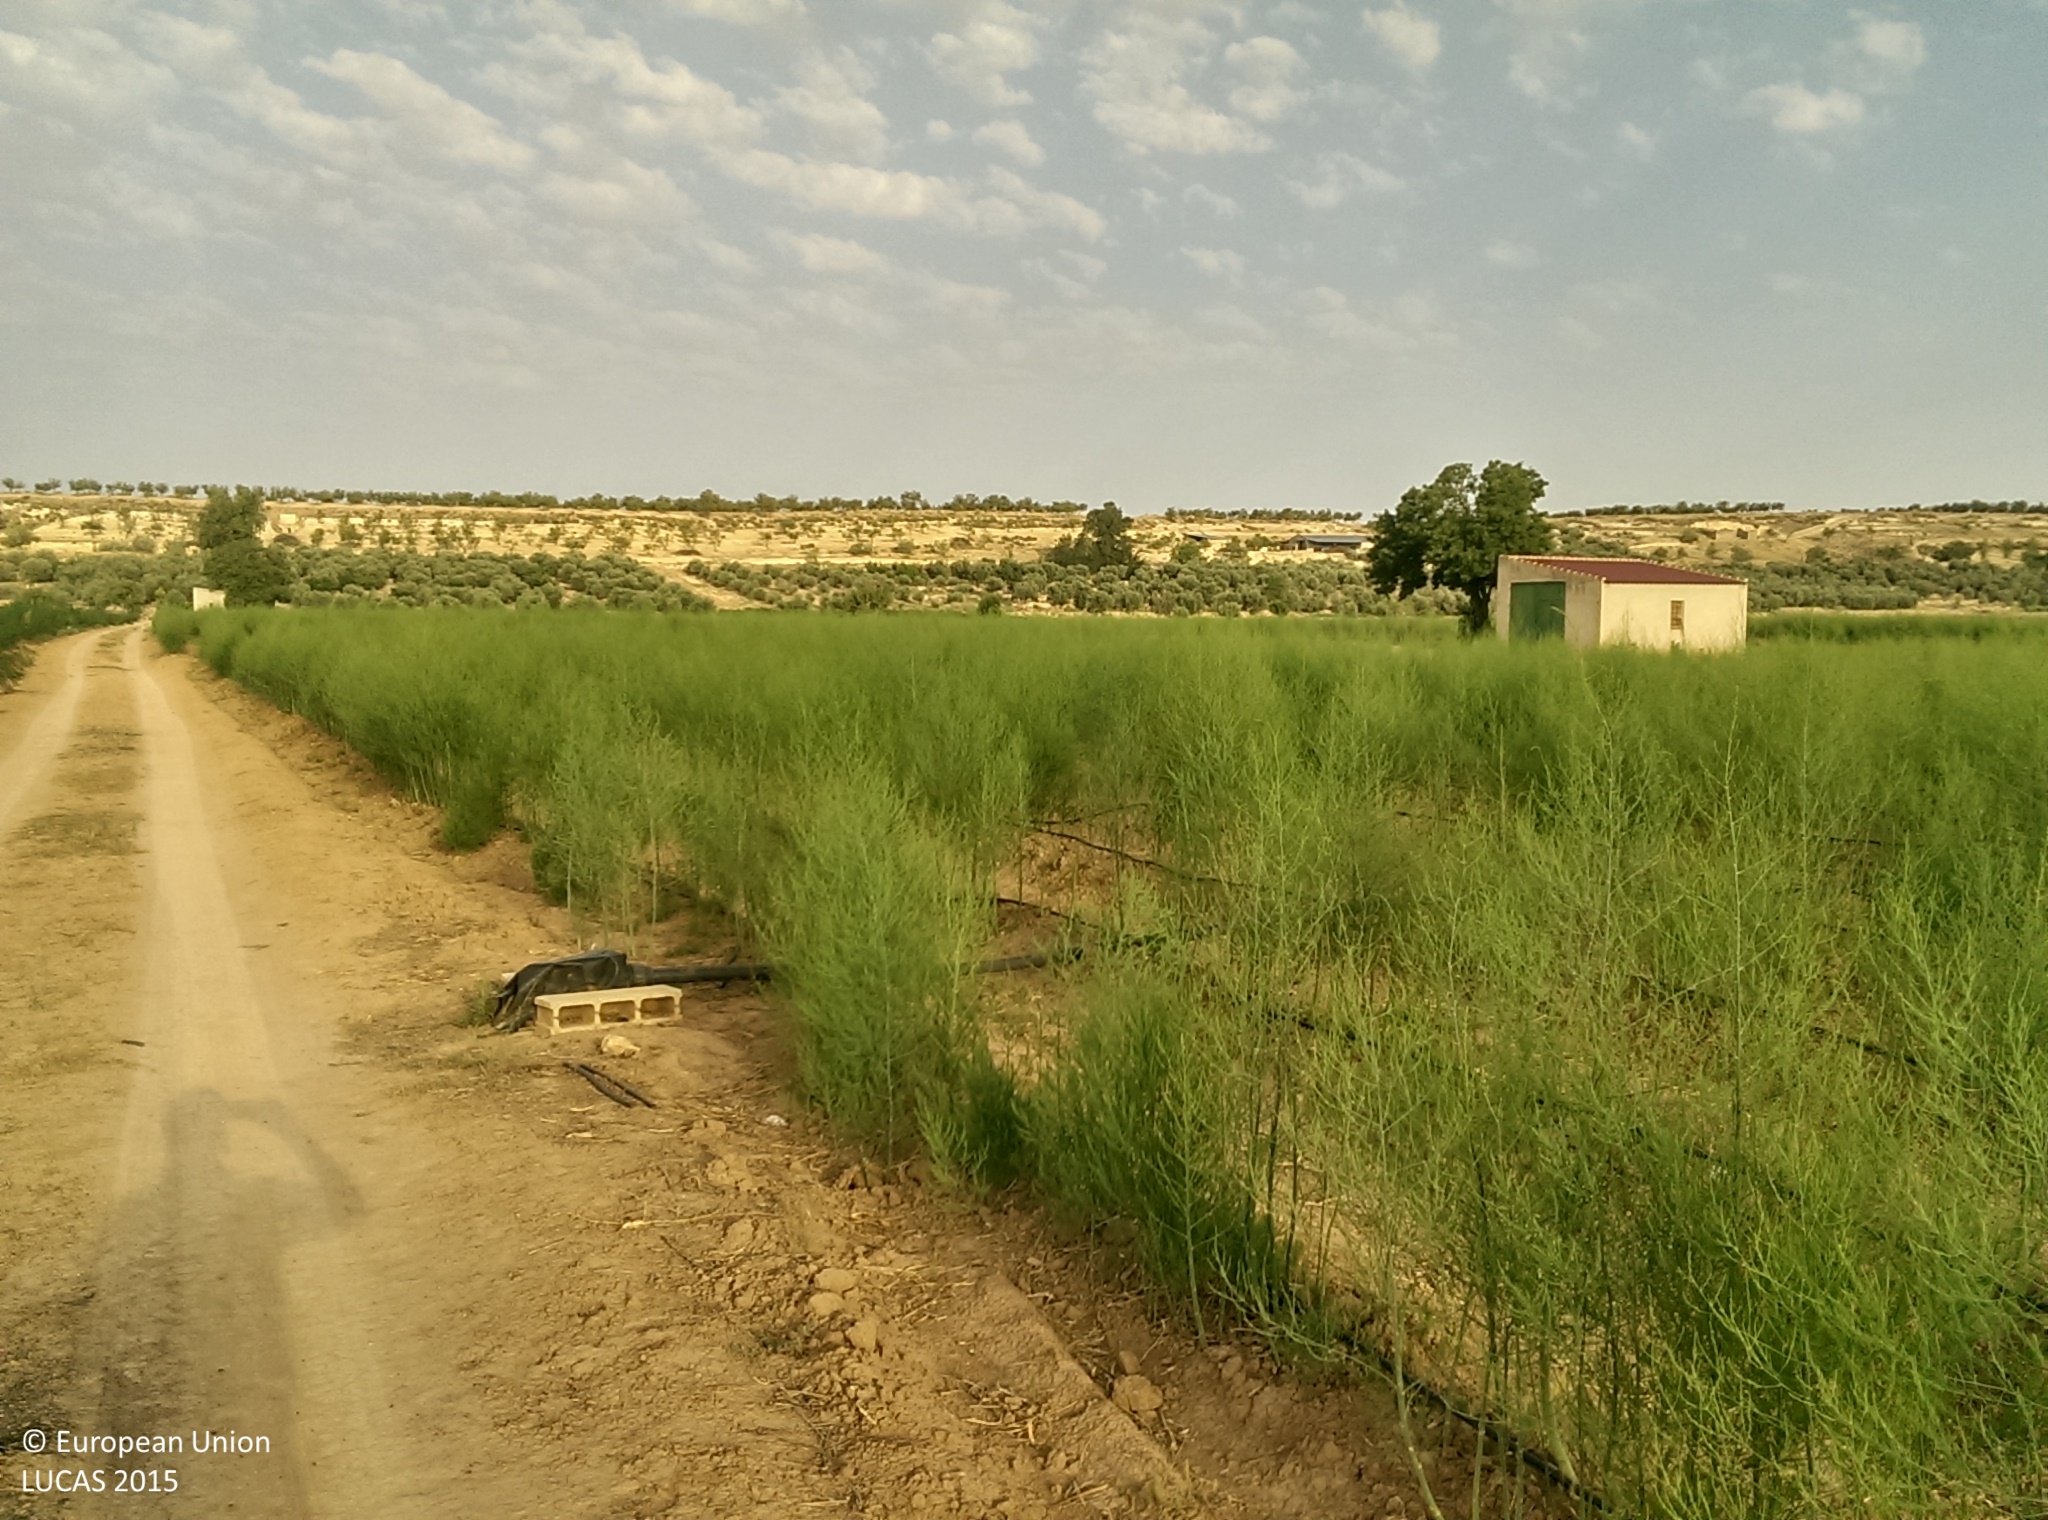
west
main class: Cropland
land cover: Other fresh vegetables
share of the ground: > 75 %
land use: Agriculture (excluding fallow land and kitchen gardens)
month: July
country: ES
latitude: 37.6294
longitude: -2.9419
